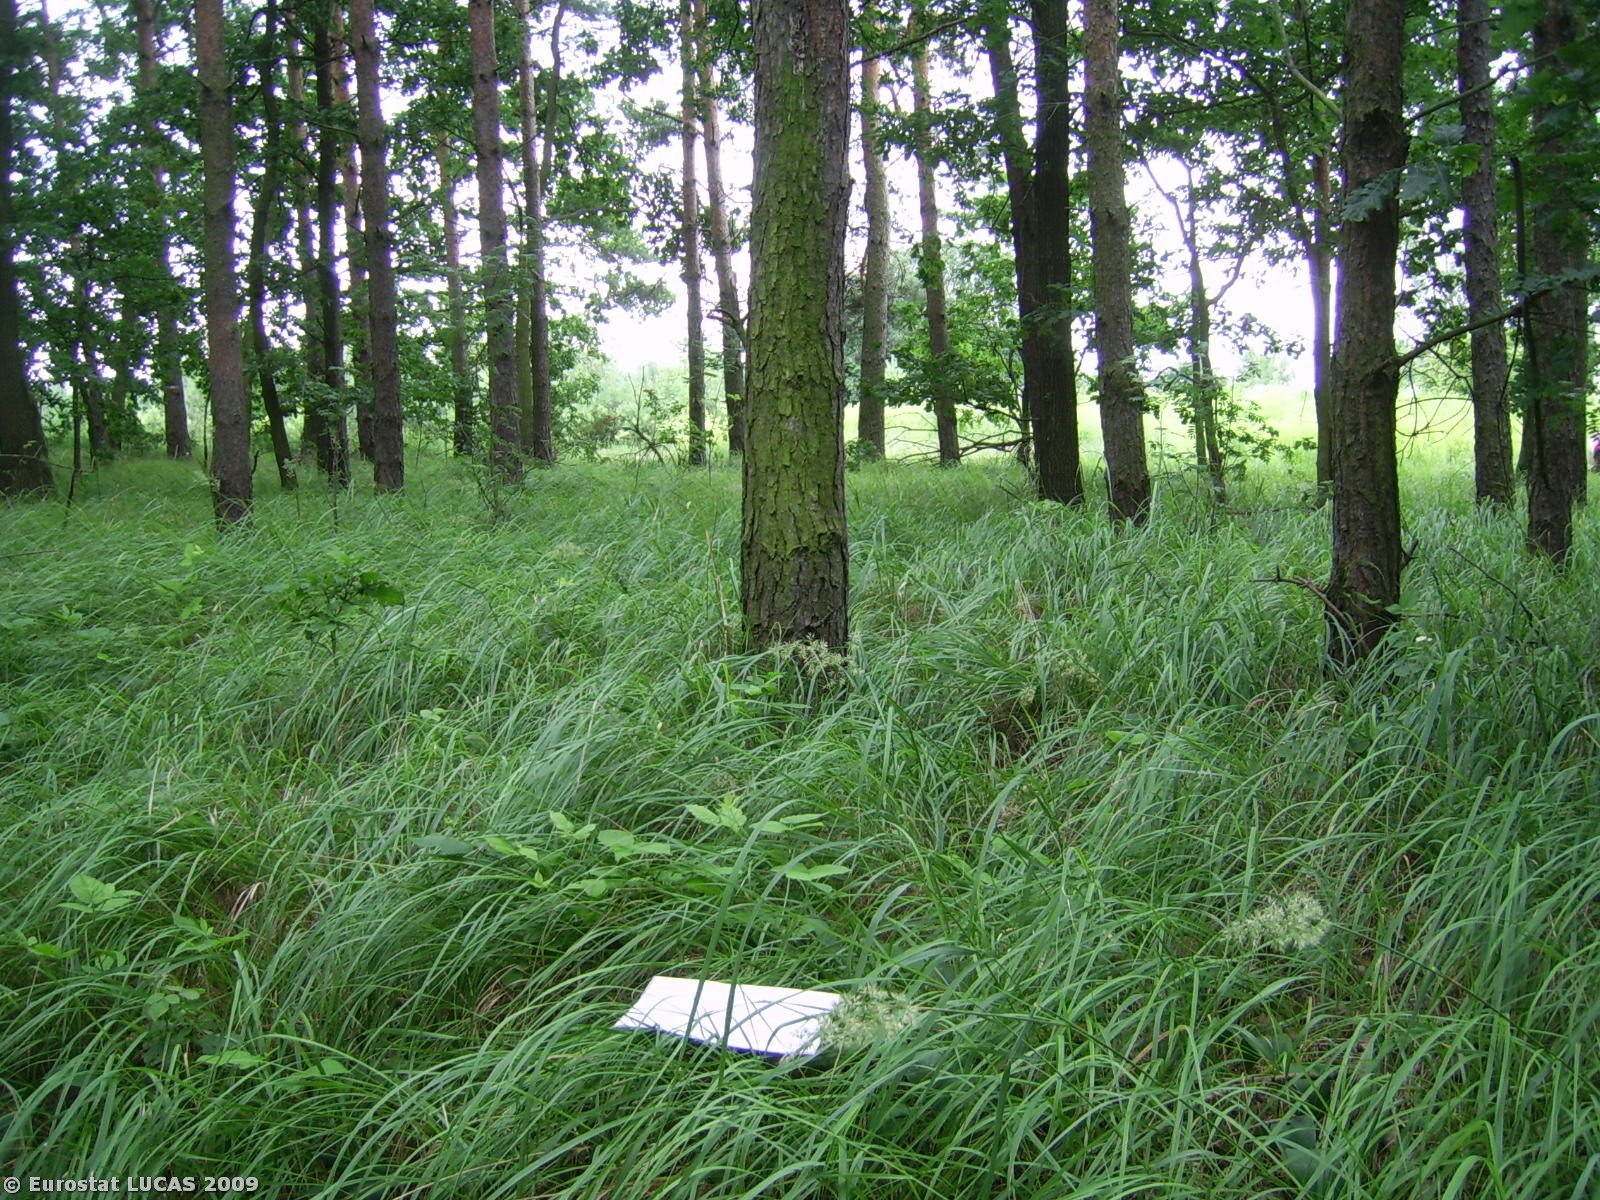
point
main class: Woodland
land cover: Mixed woodland
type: hemiboreal forest and nemoral coniferous forest and mixed broadleaved-coniferous forest
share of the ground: 50 - 75 %
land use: Unused
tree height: > 5 m
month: July
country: PL
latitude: 53.1757
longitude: 18.2305
